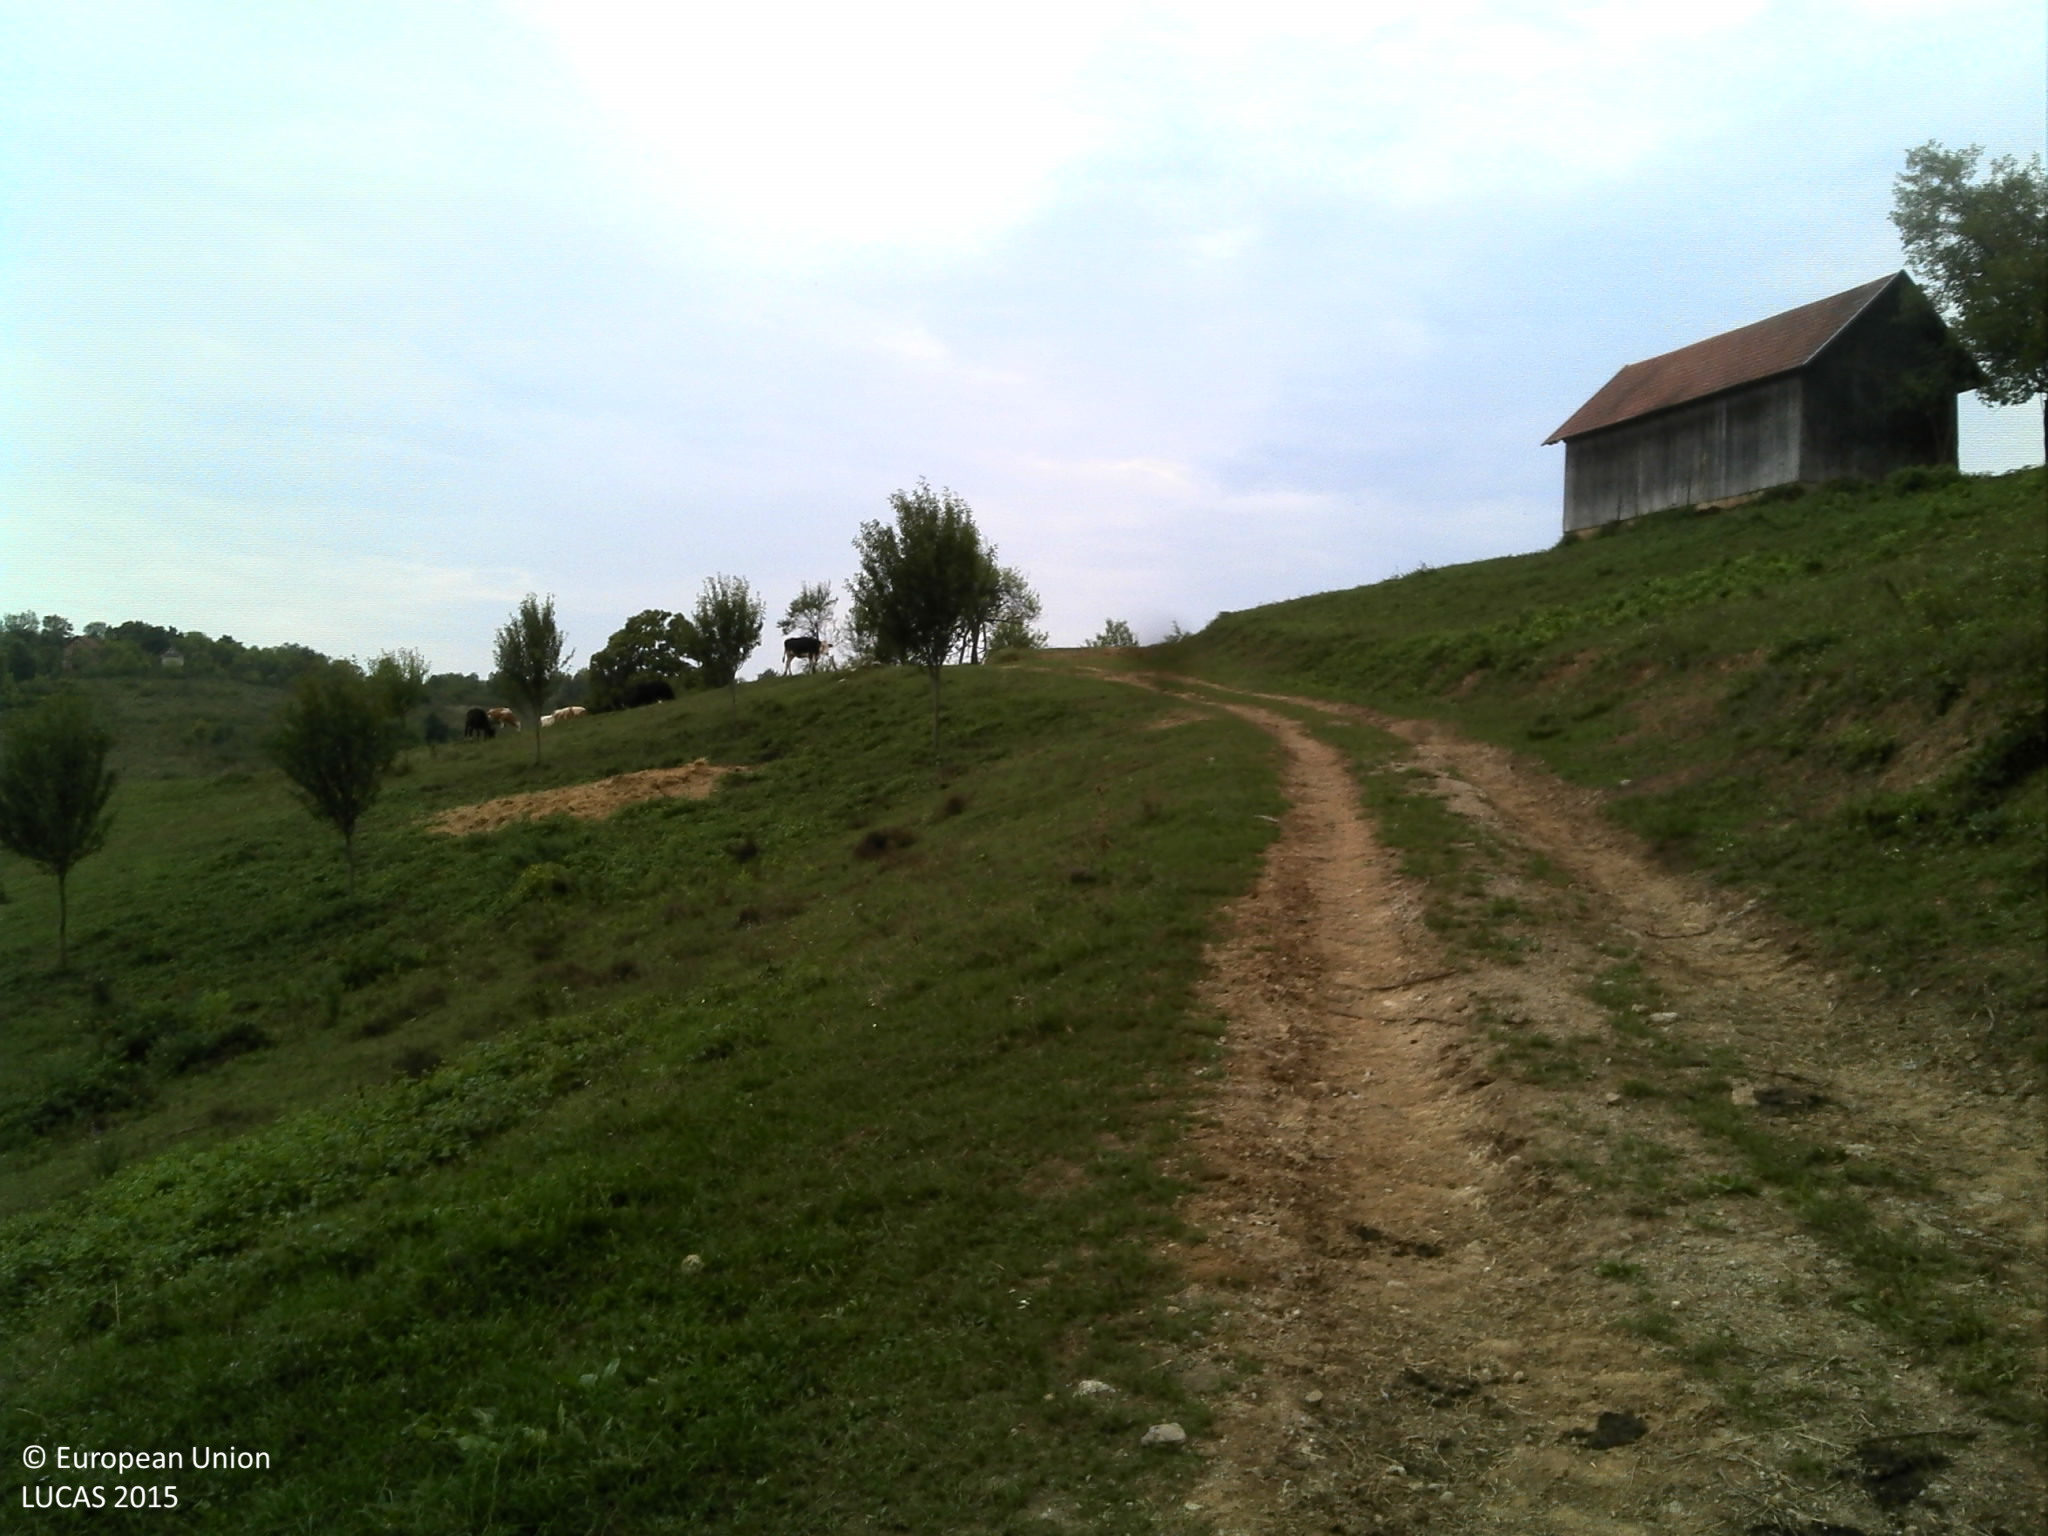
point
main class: Grassland
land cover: Grassland with sparse tree/shrub cover
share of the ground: > 75 %
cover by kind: herbaceous plants 95 %, broadleaved forest trees 5 %
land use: Agriculture (excluding fallow land and kitchen gardens)
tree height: < 5 m
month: September
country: HR
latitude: 45.1721
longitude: 15.6577
